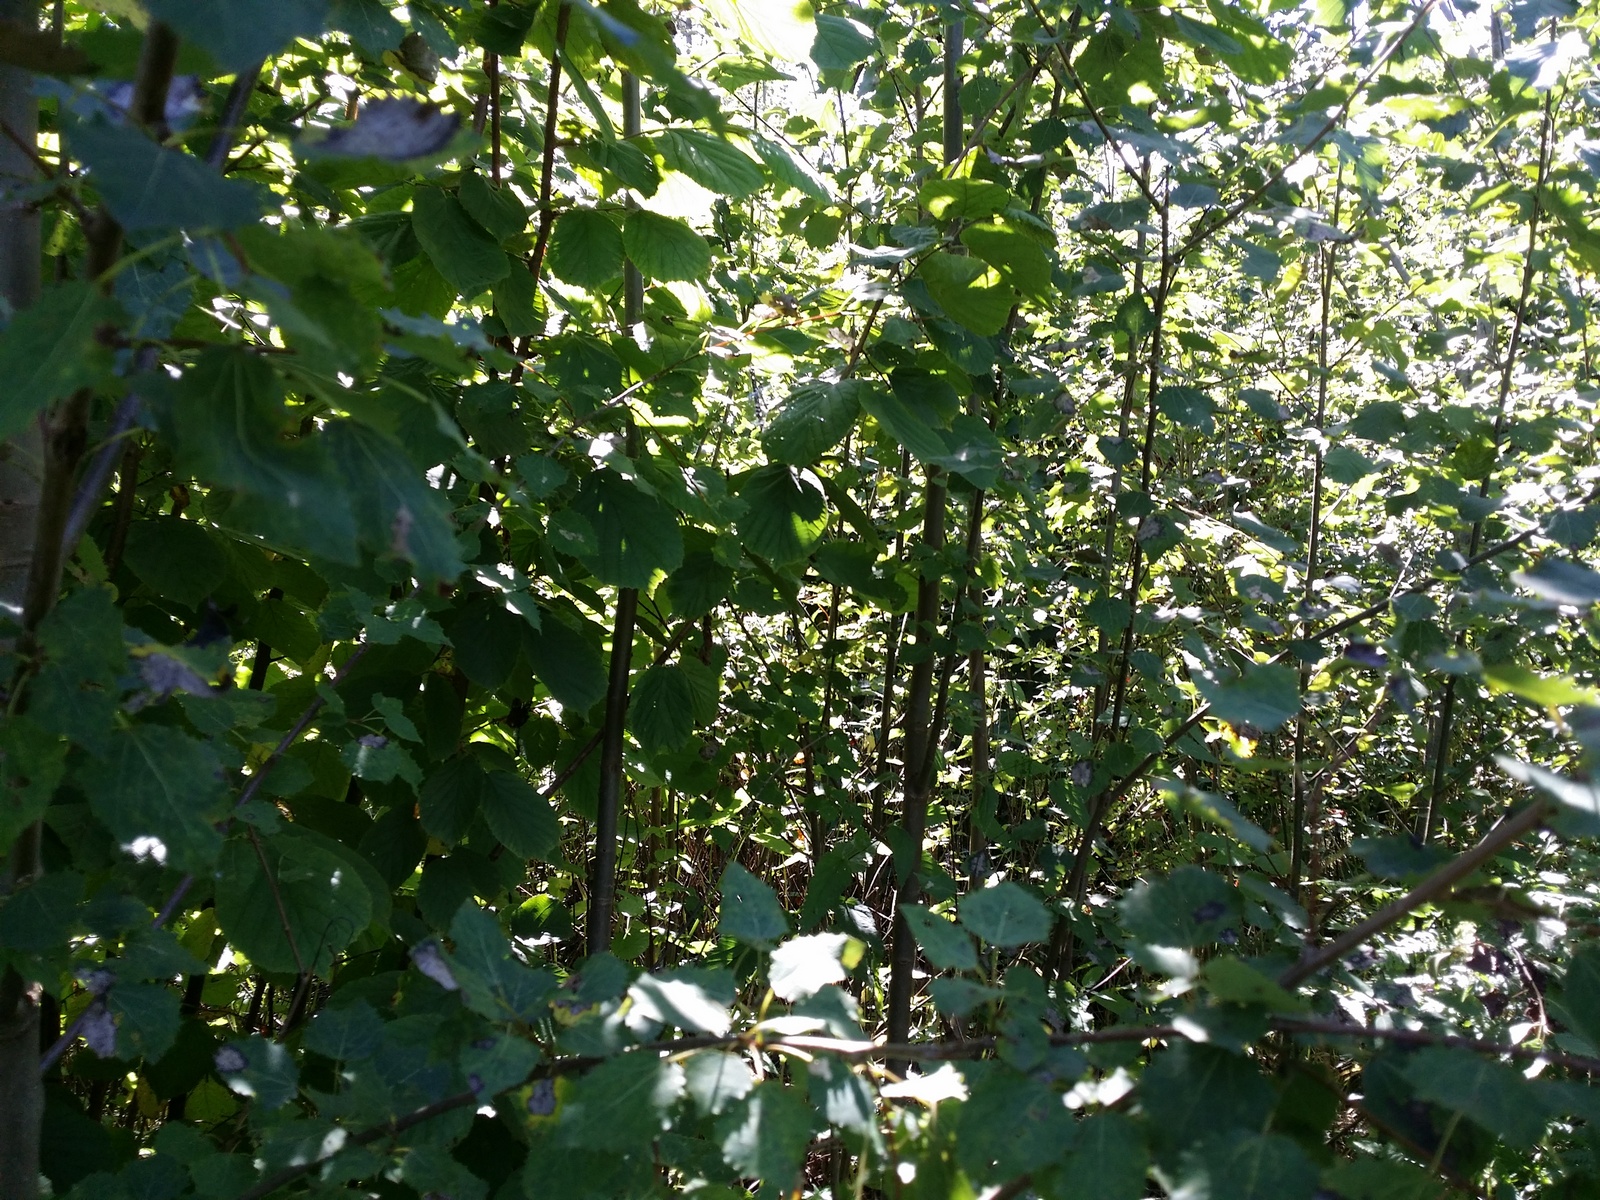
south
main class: Woodland
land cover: Broadleaved woodland
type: non-riverine alder, birch or aspen forest
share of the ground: > 75 %
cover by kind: broadleaved forest trees 90 %, herbaceous plants 10 %
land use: Forestry
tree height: < 5 m
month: August
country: LV
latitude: 57.0515
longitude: 27.6734
